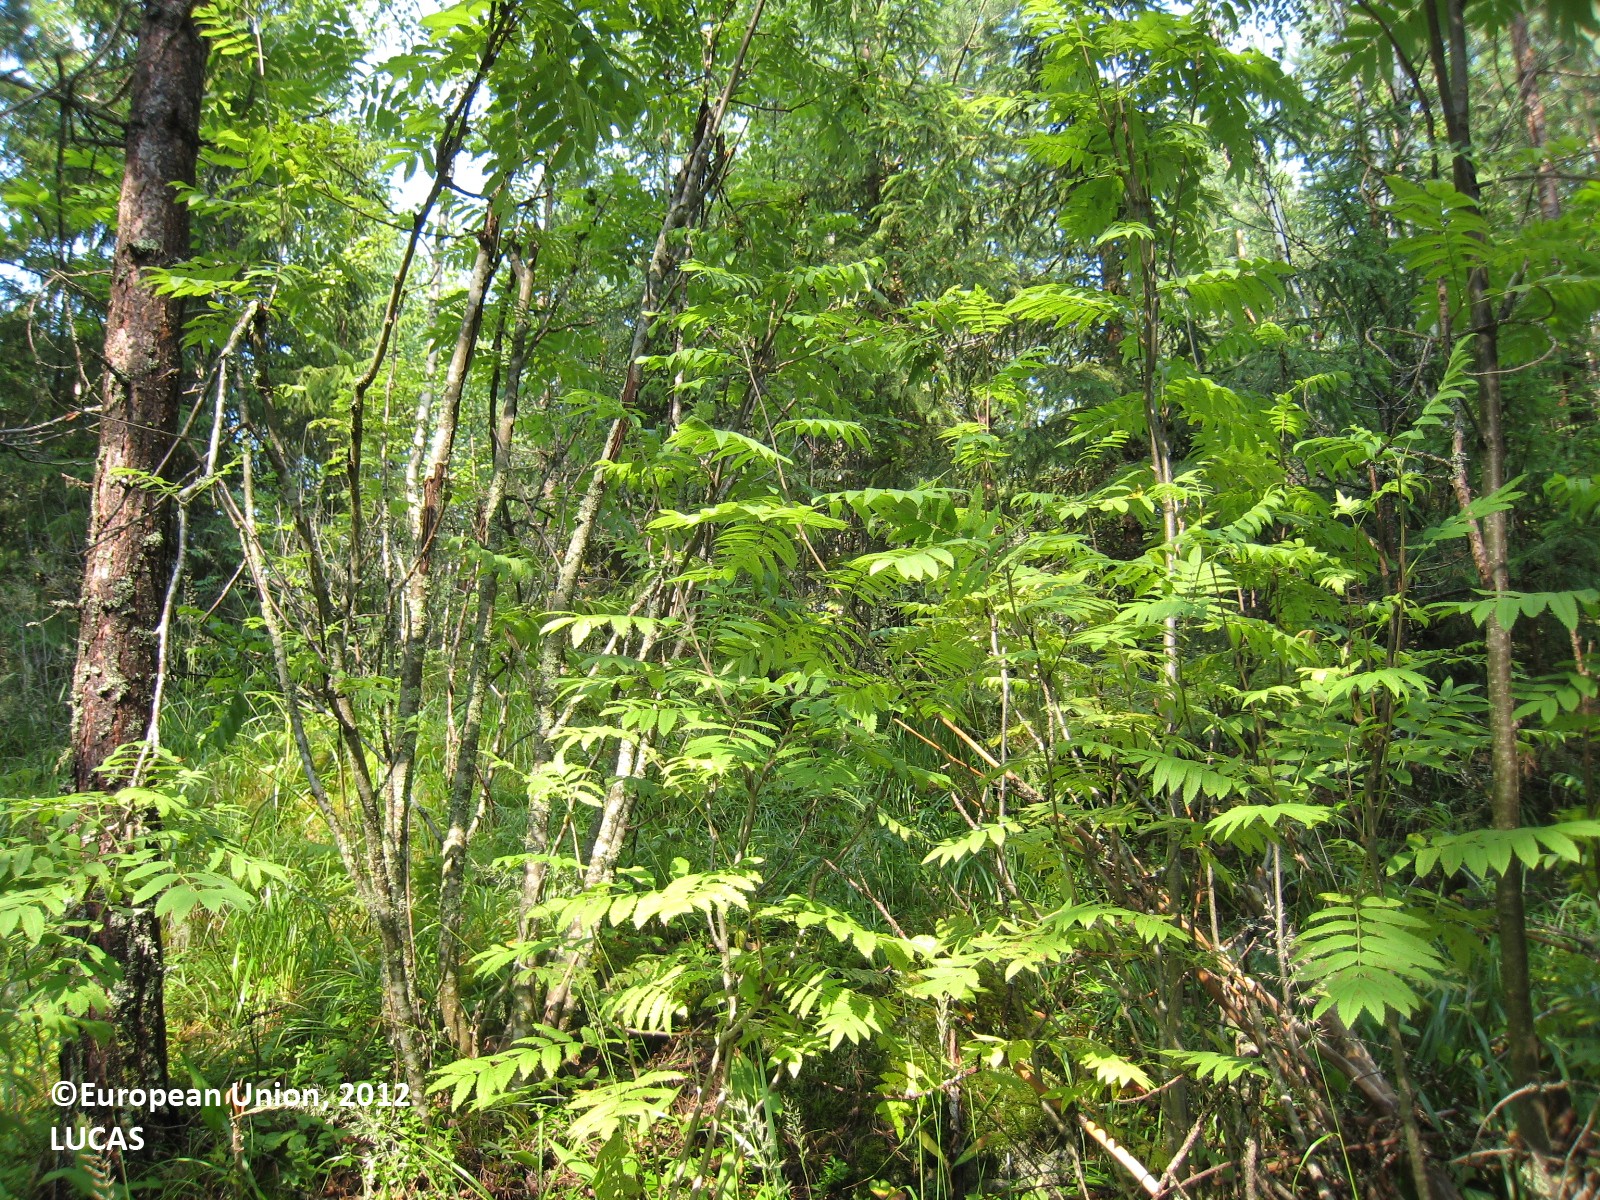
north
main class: Woodland
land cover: Other coniferous woodland
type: boreal forest
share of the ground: > 75 %
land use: Forestry
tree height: > 5 m
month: July
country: FI
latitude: 62.4588
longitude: 27.3985
